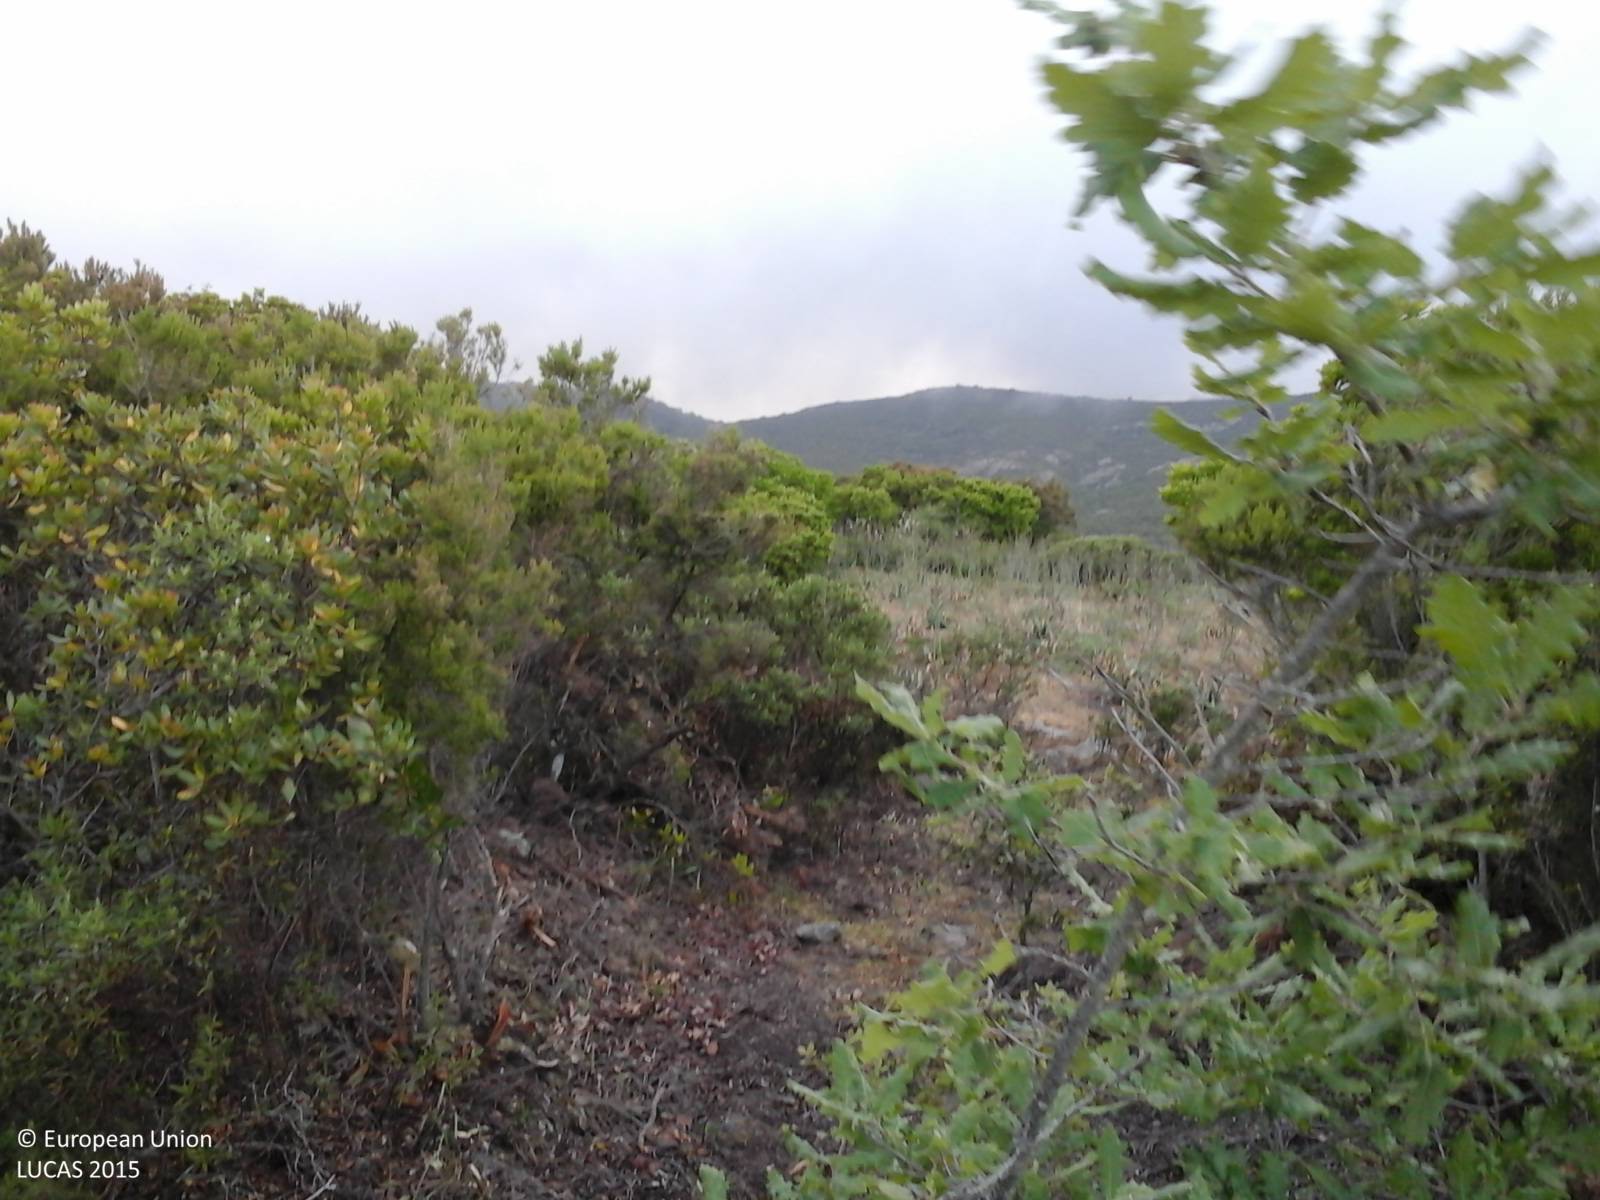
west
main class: Shrubland
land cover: Shrubland without tree cover
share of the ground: > 75 %
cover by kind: shrubs 100 %
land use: Agriculture (excluding fallow land and kitchen gardens)
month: May
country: IT
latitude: 39.7705
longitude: 8.7579
